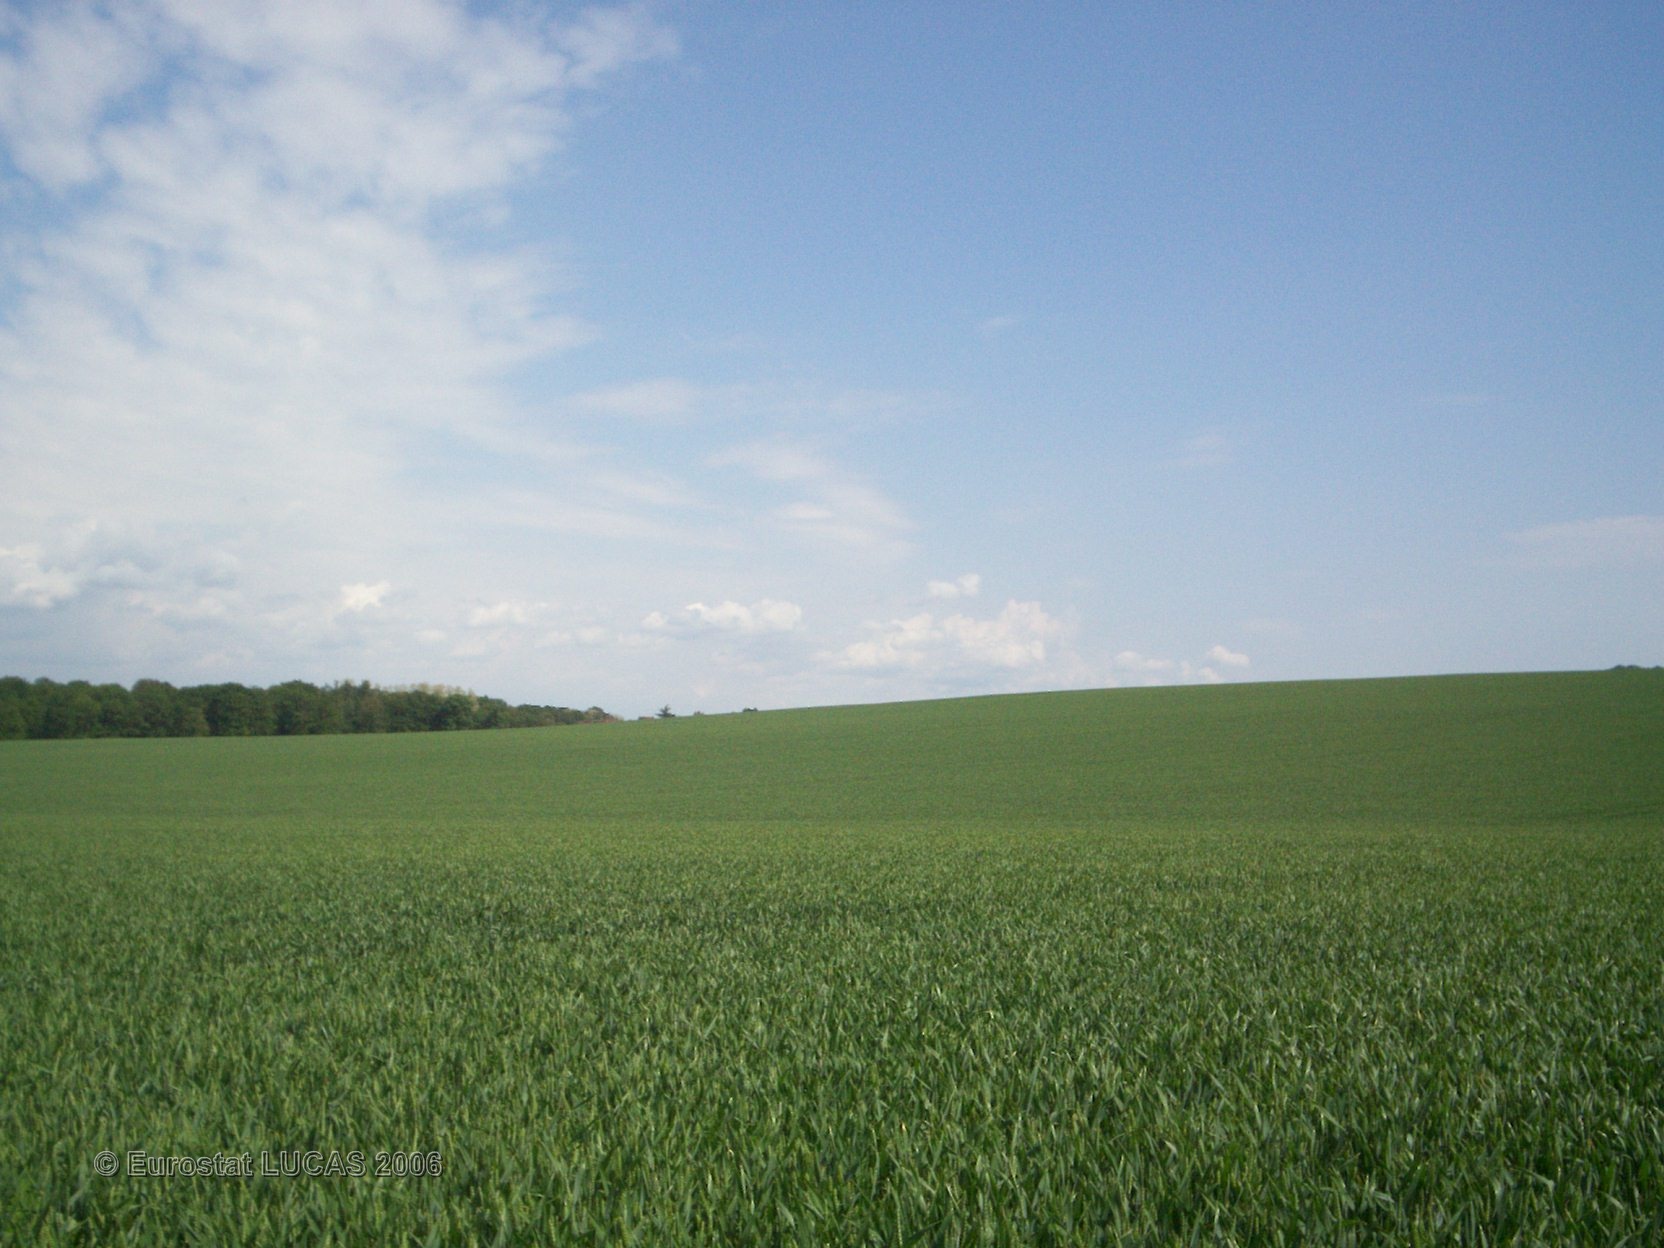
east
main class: Cropland
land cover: Common wheat
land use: Agriculture (excluding fallow land and kitchen gardens)
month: June
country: FR
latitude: 49.4100
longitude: 2.7258
